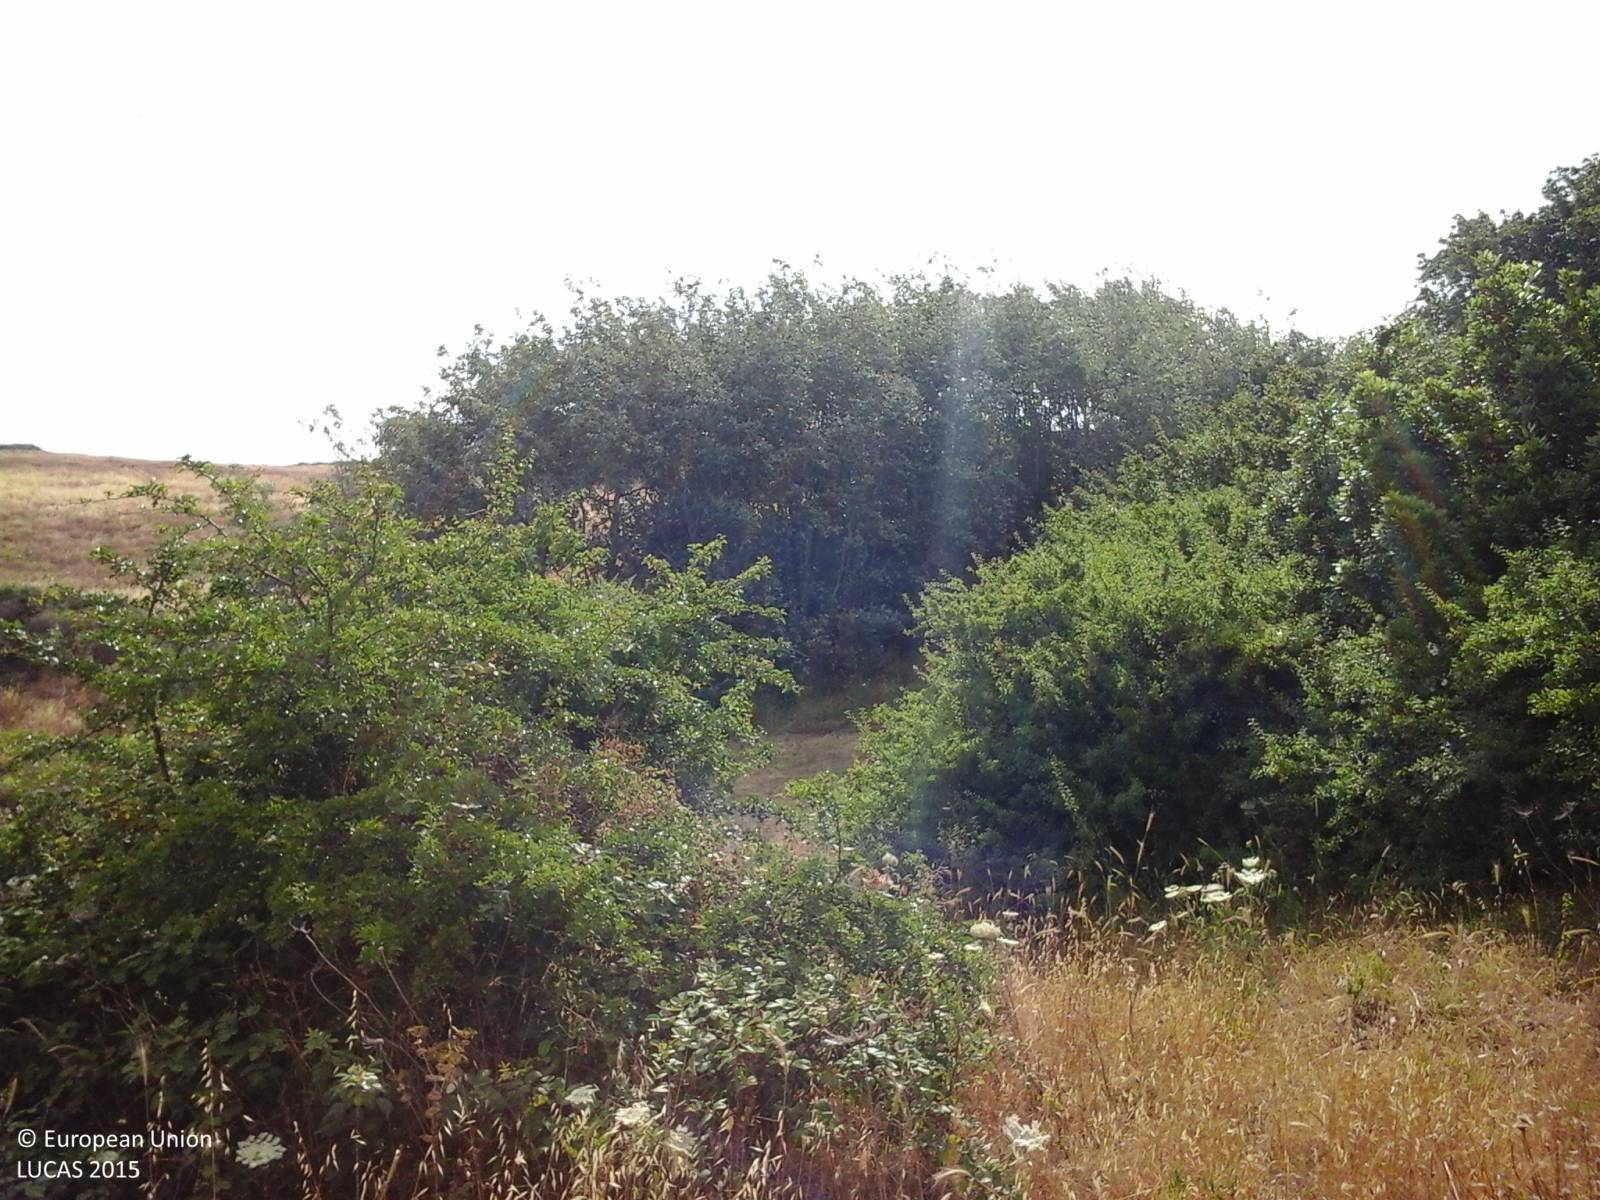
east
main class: Shrubland
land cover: Shrubland without tree cover
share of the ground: > 75 %
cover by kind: herbaceous plants 55 %, shrubs 45 %
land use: Agriculture (excluding fallow land and kitchen gardens)
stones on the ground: < 10 %
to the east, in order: Shrubland without tree cover; Grassland without tree/shrub cover; Broadleaved woodland; Fences; Grassland without tree/shrub cover; Single bushes/trees; Grassland without tree/shrub cover; Single bushes/trees; Grassland without tree/shrub cover; Fences; Dry stone walls; Tracks; Dry stone walls; Fences; Grassland without tree/shrub cover; Abandoned hedges; Fences; Grassland without tree/shrub cover
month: June
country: IT
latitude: 40.7651
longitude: 8.6677
